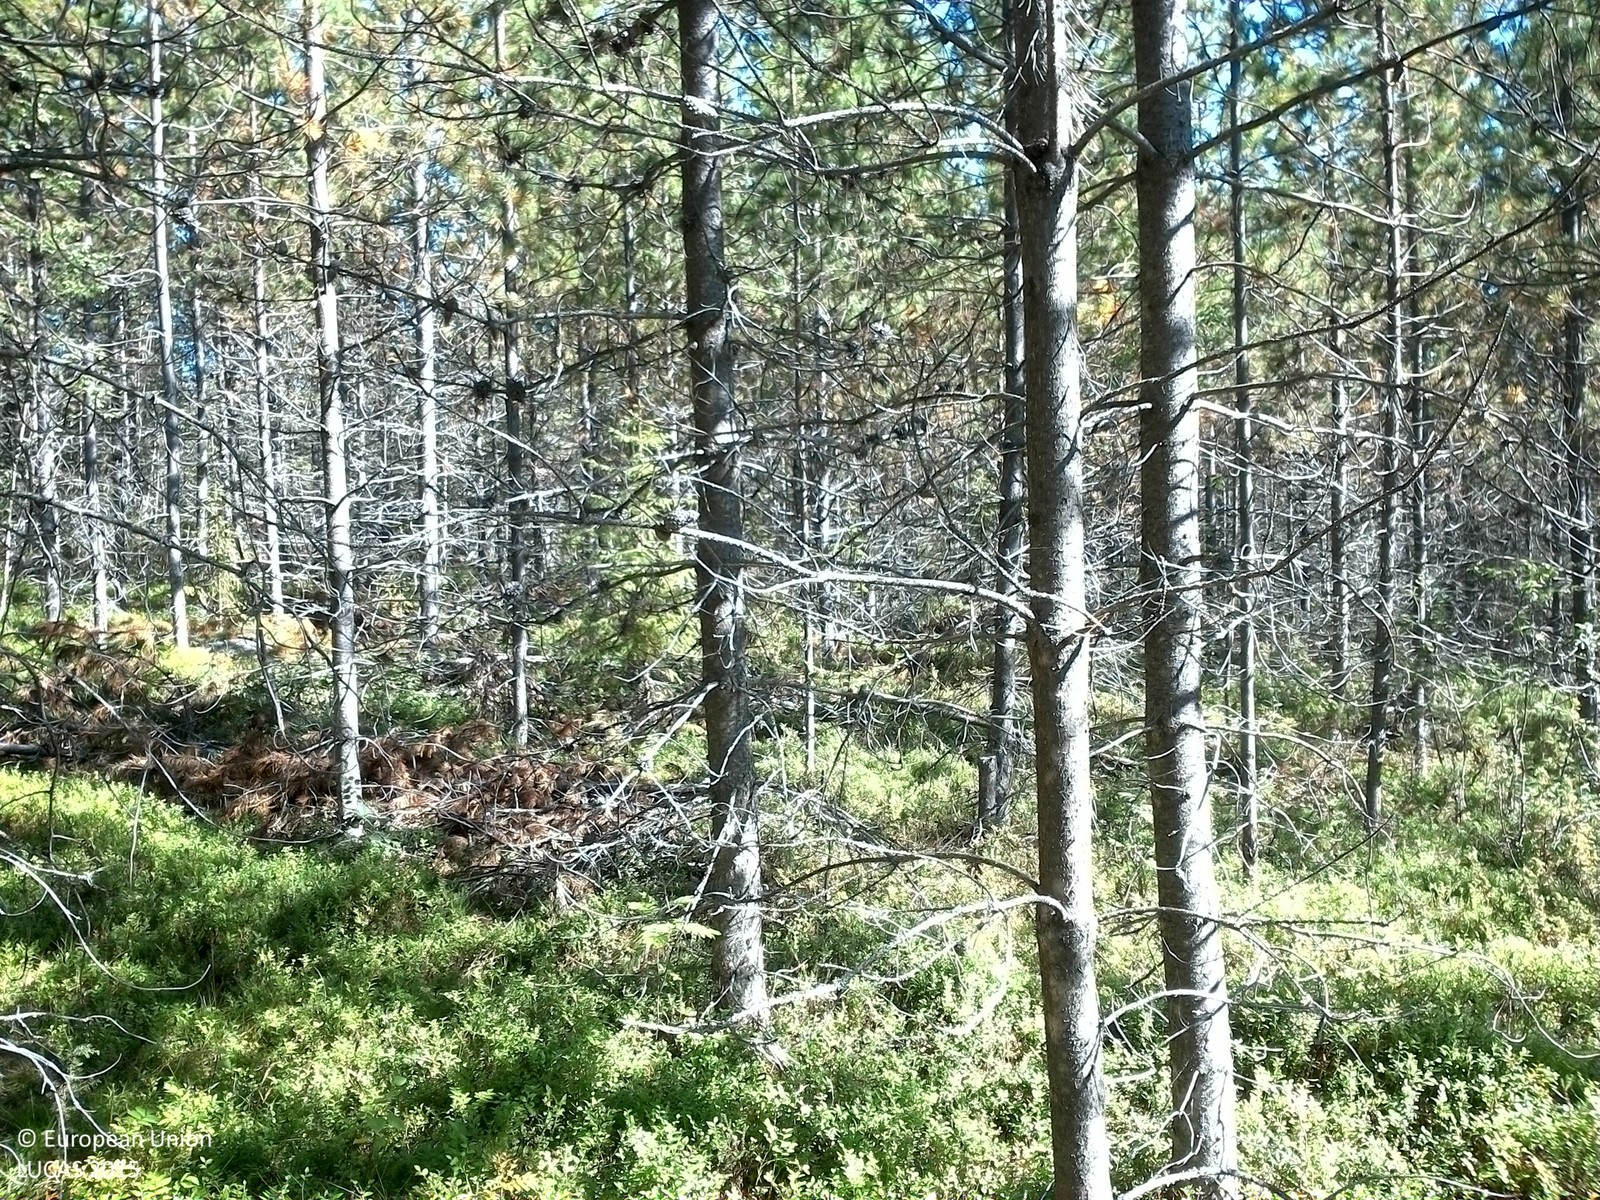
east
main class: Woodland
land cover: Pine dominated coniferous woodland
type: exotic forest
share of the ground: > 75 %
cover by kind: coniferous forest trees 85 %, shrubs 15 %
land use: Forestry
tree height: < 5 m
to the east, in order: Pine dominated coniferous woodland; Pine dominated mixed woodland; Paved roads, cycling and walking lanes; Ditches and canals; Pine dominated coniferous woodland; Ditches and canals; Pine dominated mixed woodland; Pine dominated coniferous woodland
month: August
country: SE
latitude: 63.6720
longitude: 17.5919
